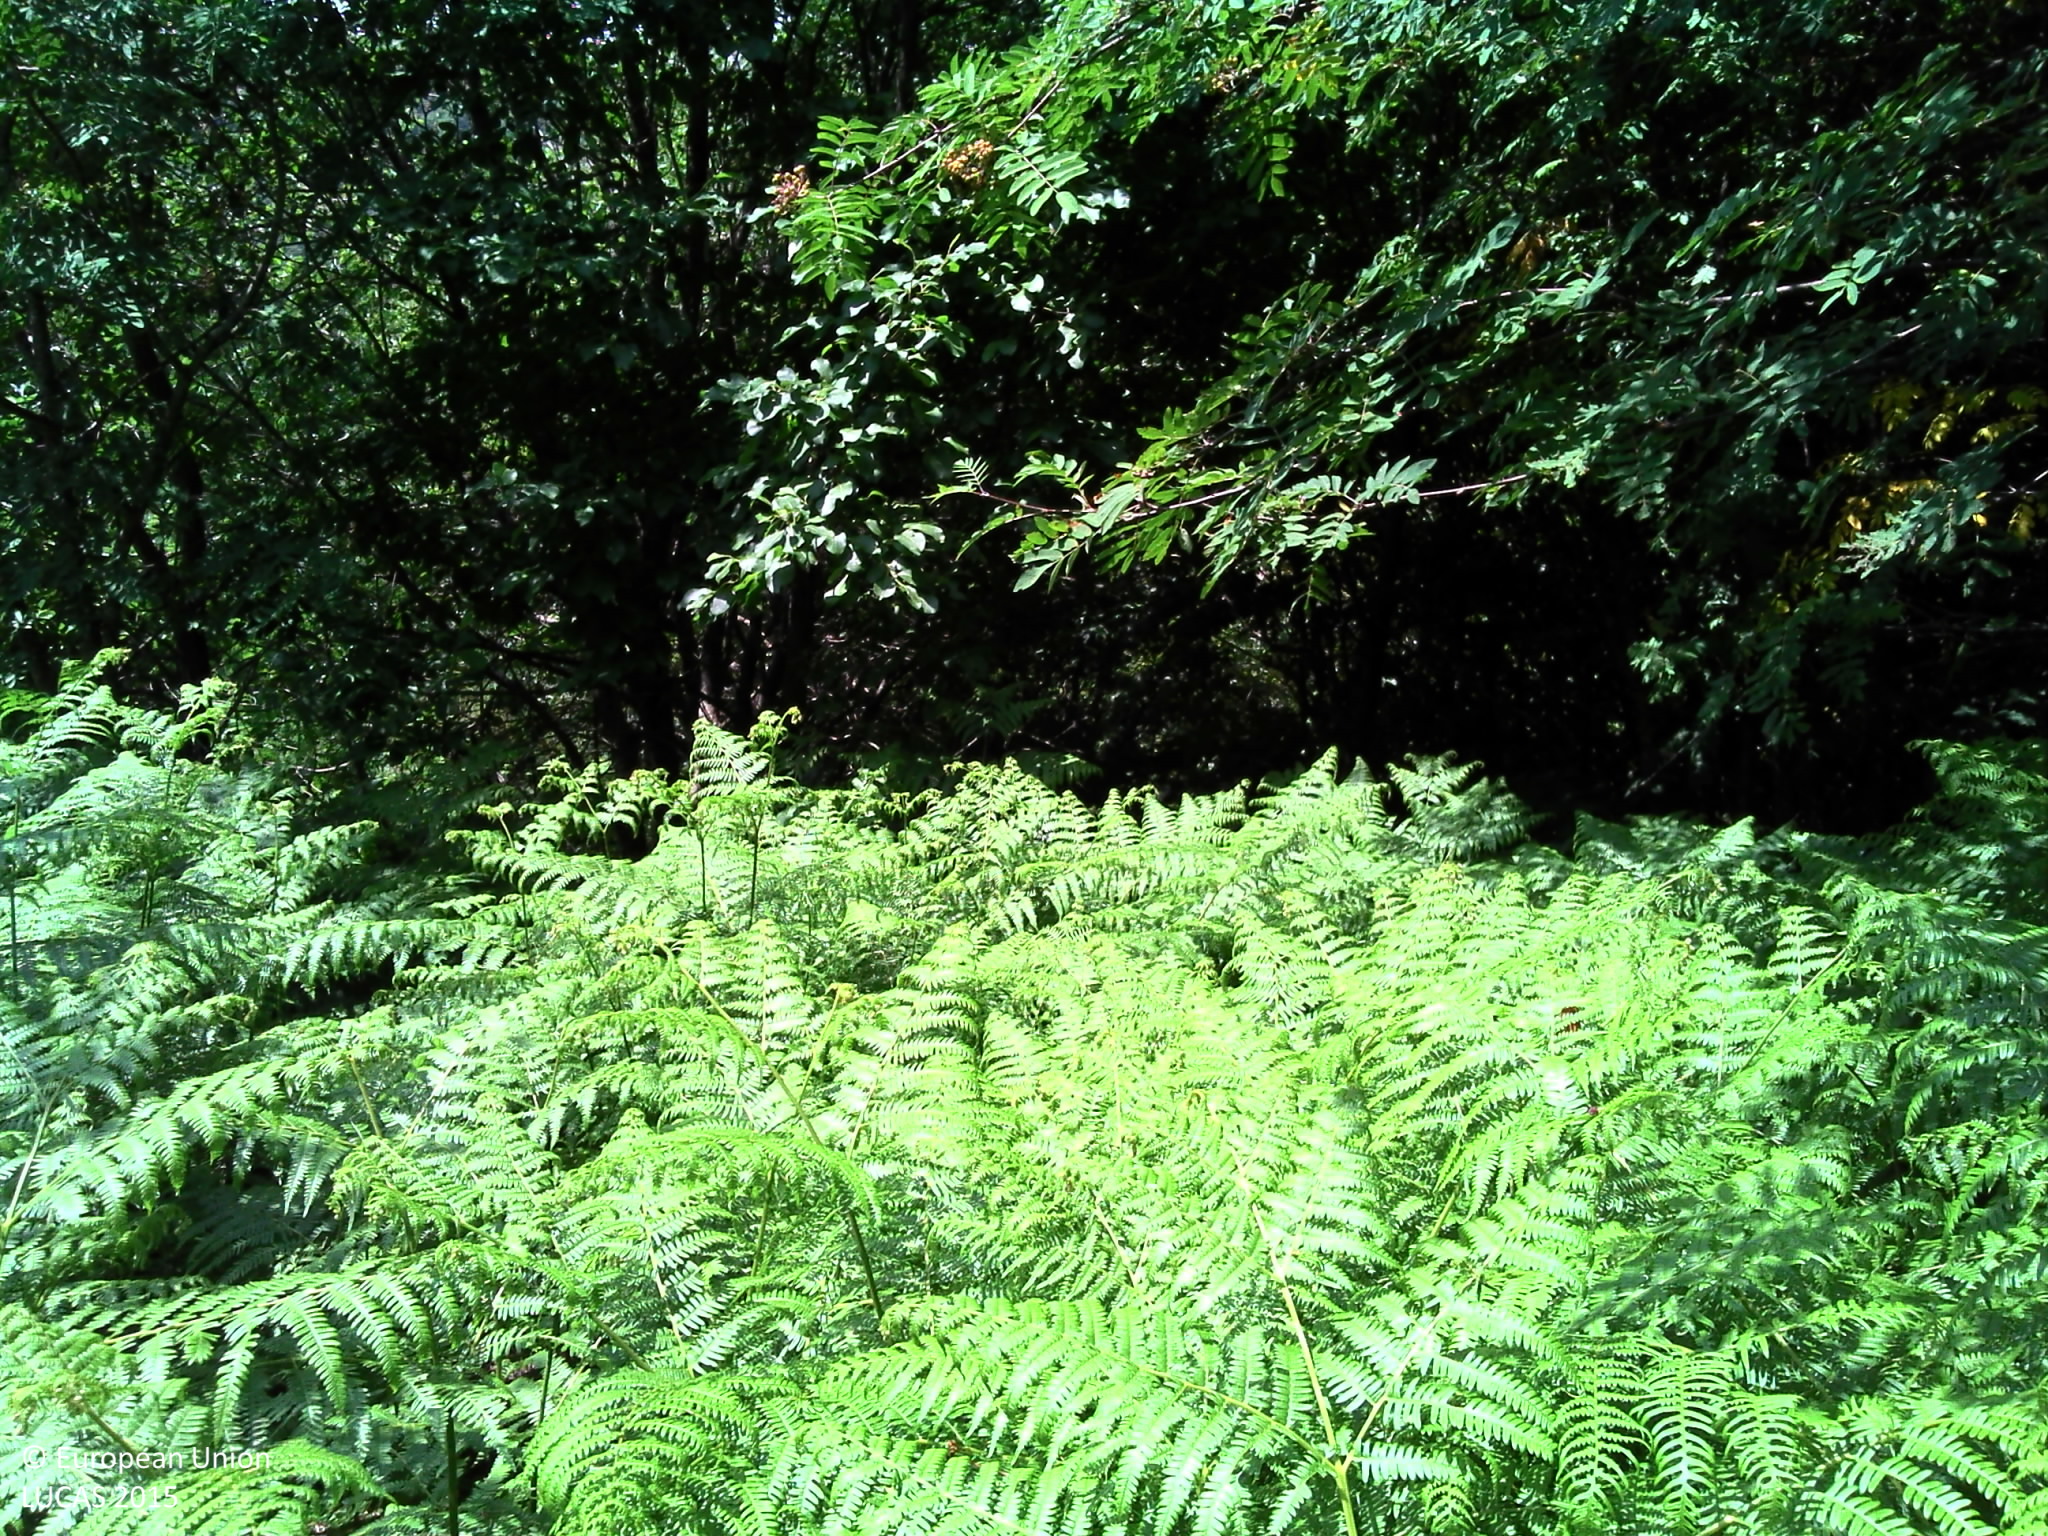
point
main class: Woodland
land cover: Broadleaved woodland
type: beech forest
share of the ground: > 75 %
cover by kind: broadleaved forest trees 80 %, herbaceous plants 20 %
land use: Forestry
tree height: > 5 m
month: July
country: FR
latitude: 44.5333
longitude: 3.0450
